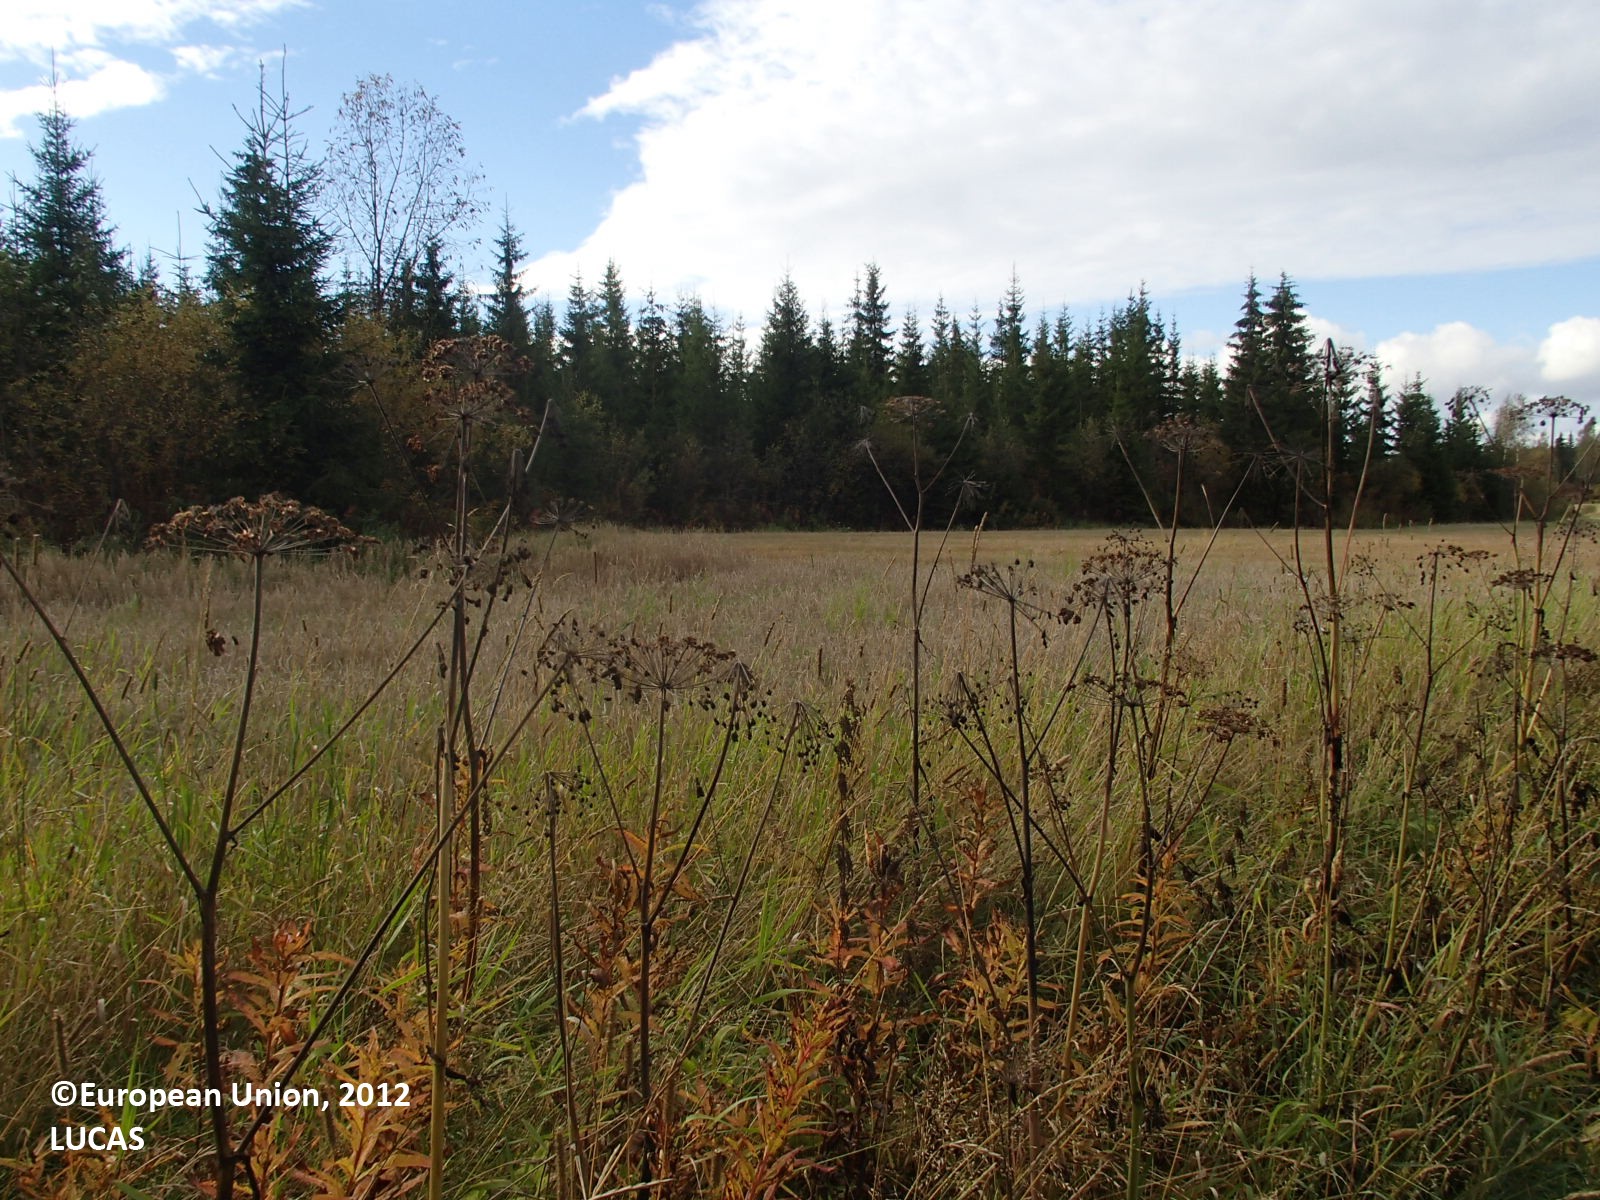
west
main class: Cropland
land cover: Temporary grasslands
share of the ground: > 75 %
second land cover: Barley
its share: 50 - 75 %
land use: Agriculture (excluding fallow land and kitchen gardens)
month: September
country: FI
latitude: 63.3439
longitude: 27.9330
